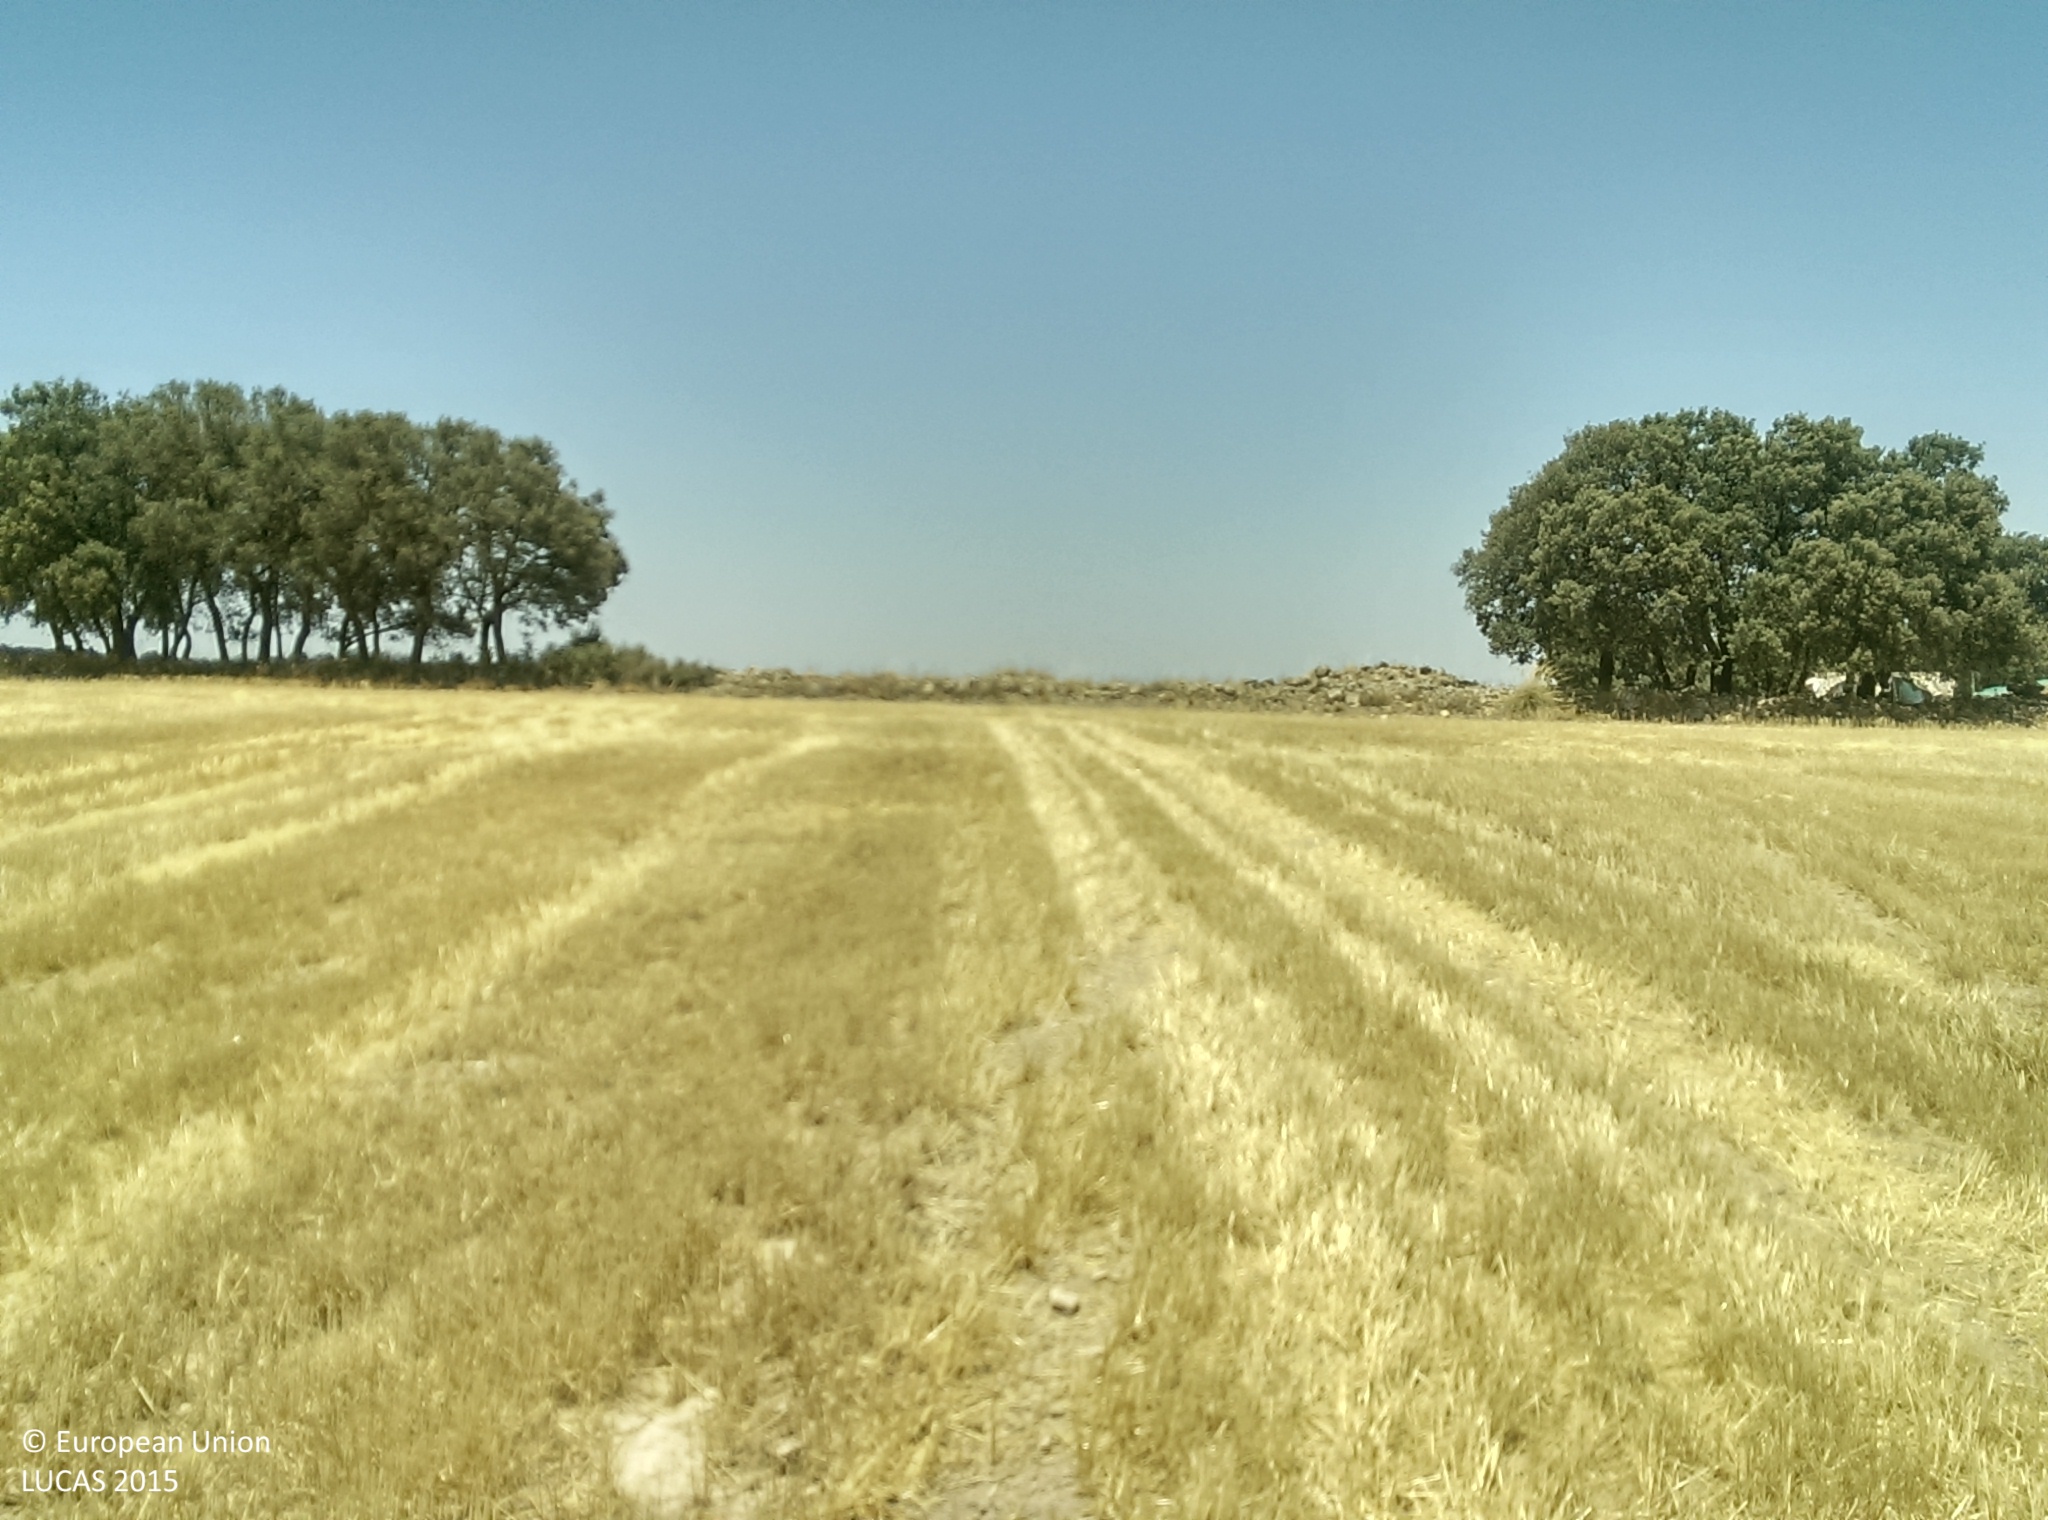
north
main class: Cropland
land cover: Barley
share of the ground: < 10 %
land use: Agriculture (excluding fallow land and kitchen gardens)
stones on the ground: 10 - 25 %
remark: Harvested field
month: July
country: ES
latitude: 37.4727
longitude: -3.2772
